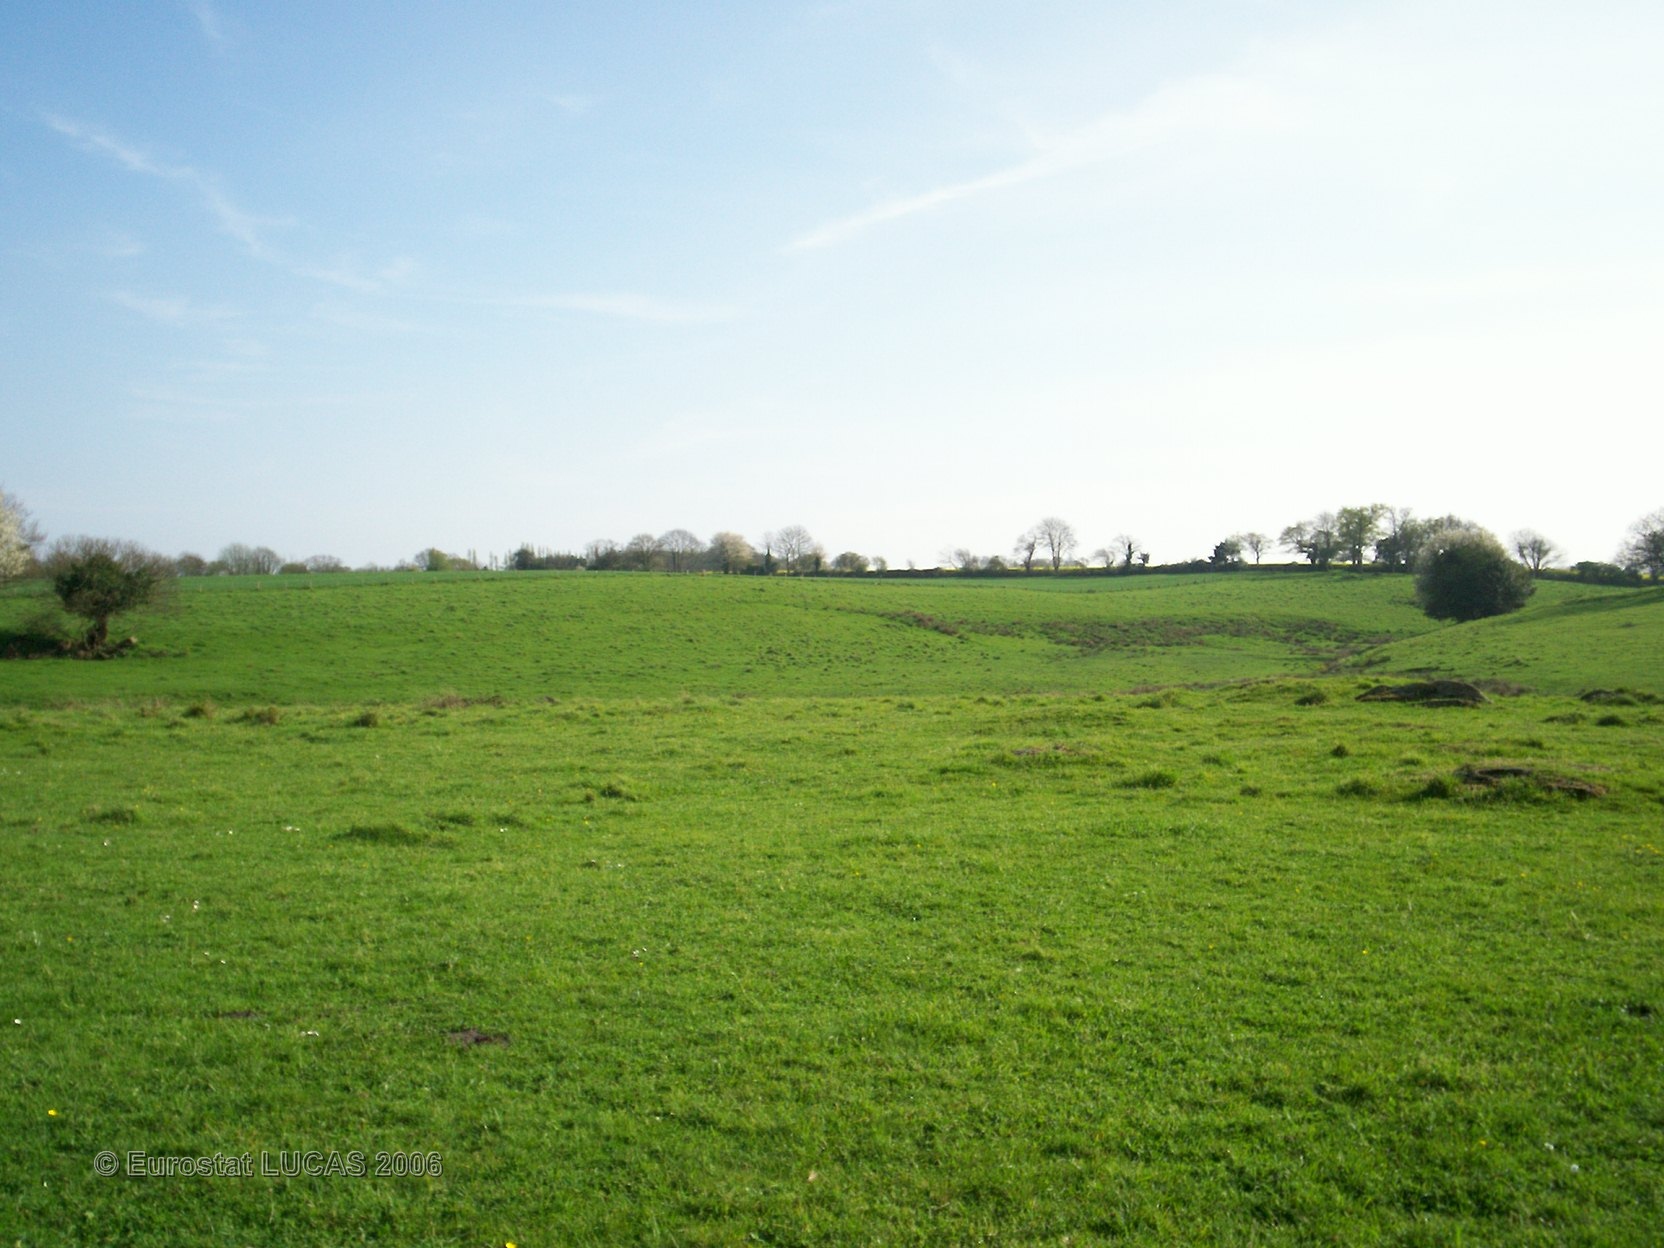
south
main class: Grassland
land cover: Grassland without tree/shrub cover
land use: Agriculture (excluding fallow land and kitchen gardens)
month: April
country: FR
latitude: 47.6522
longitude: -2.8308
